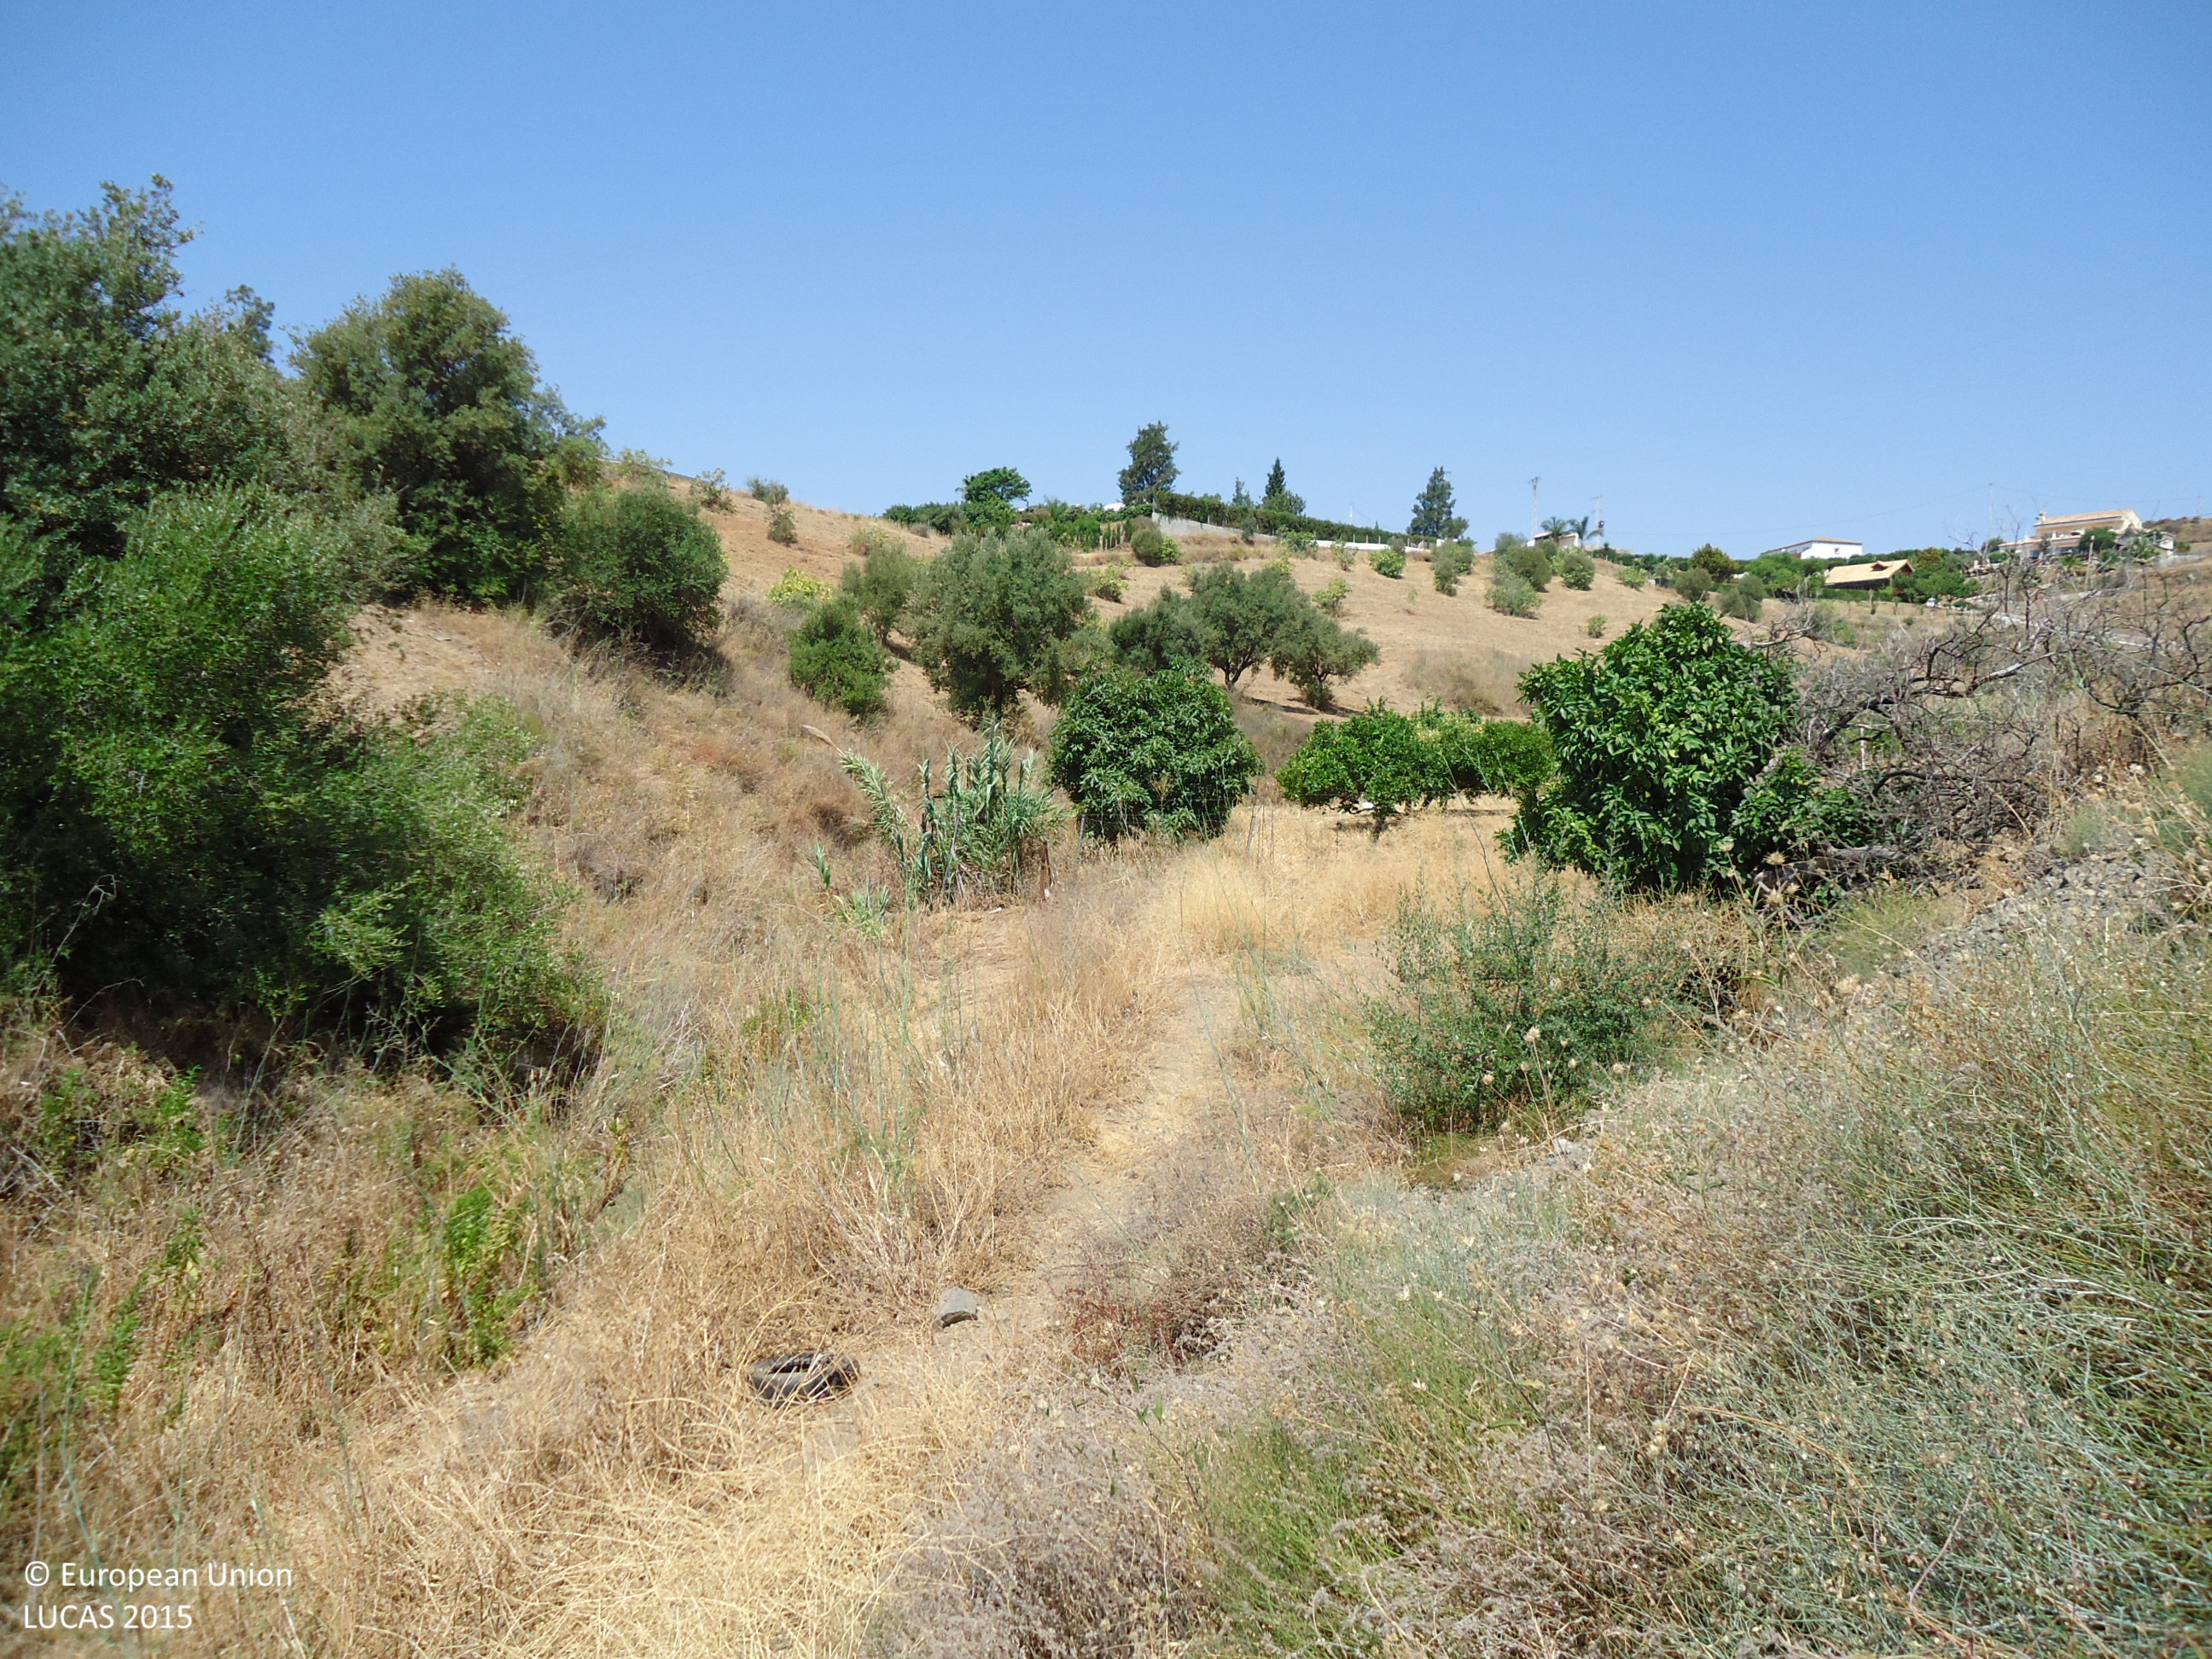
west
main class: Grassland
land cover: Grassland without tree/shrub cover
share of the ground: > 75 %
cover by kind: herbaceous plants 90 %, unconsolidated bare surface 10 %
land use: Semi-natural and natural areas not in use
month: July
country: ES
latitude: 36.5251
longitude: -4.6976
